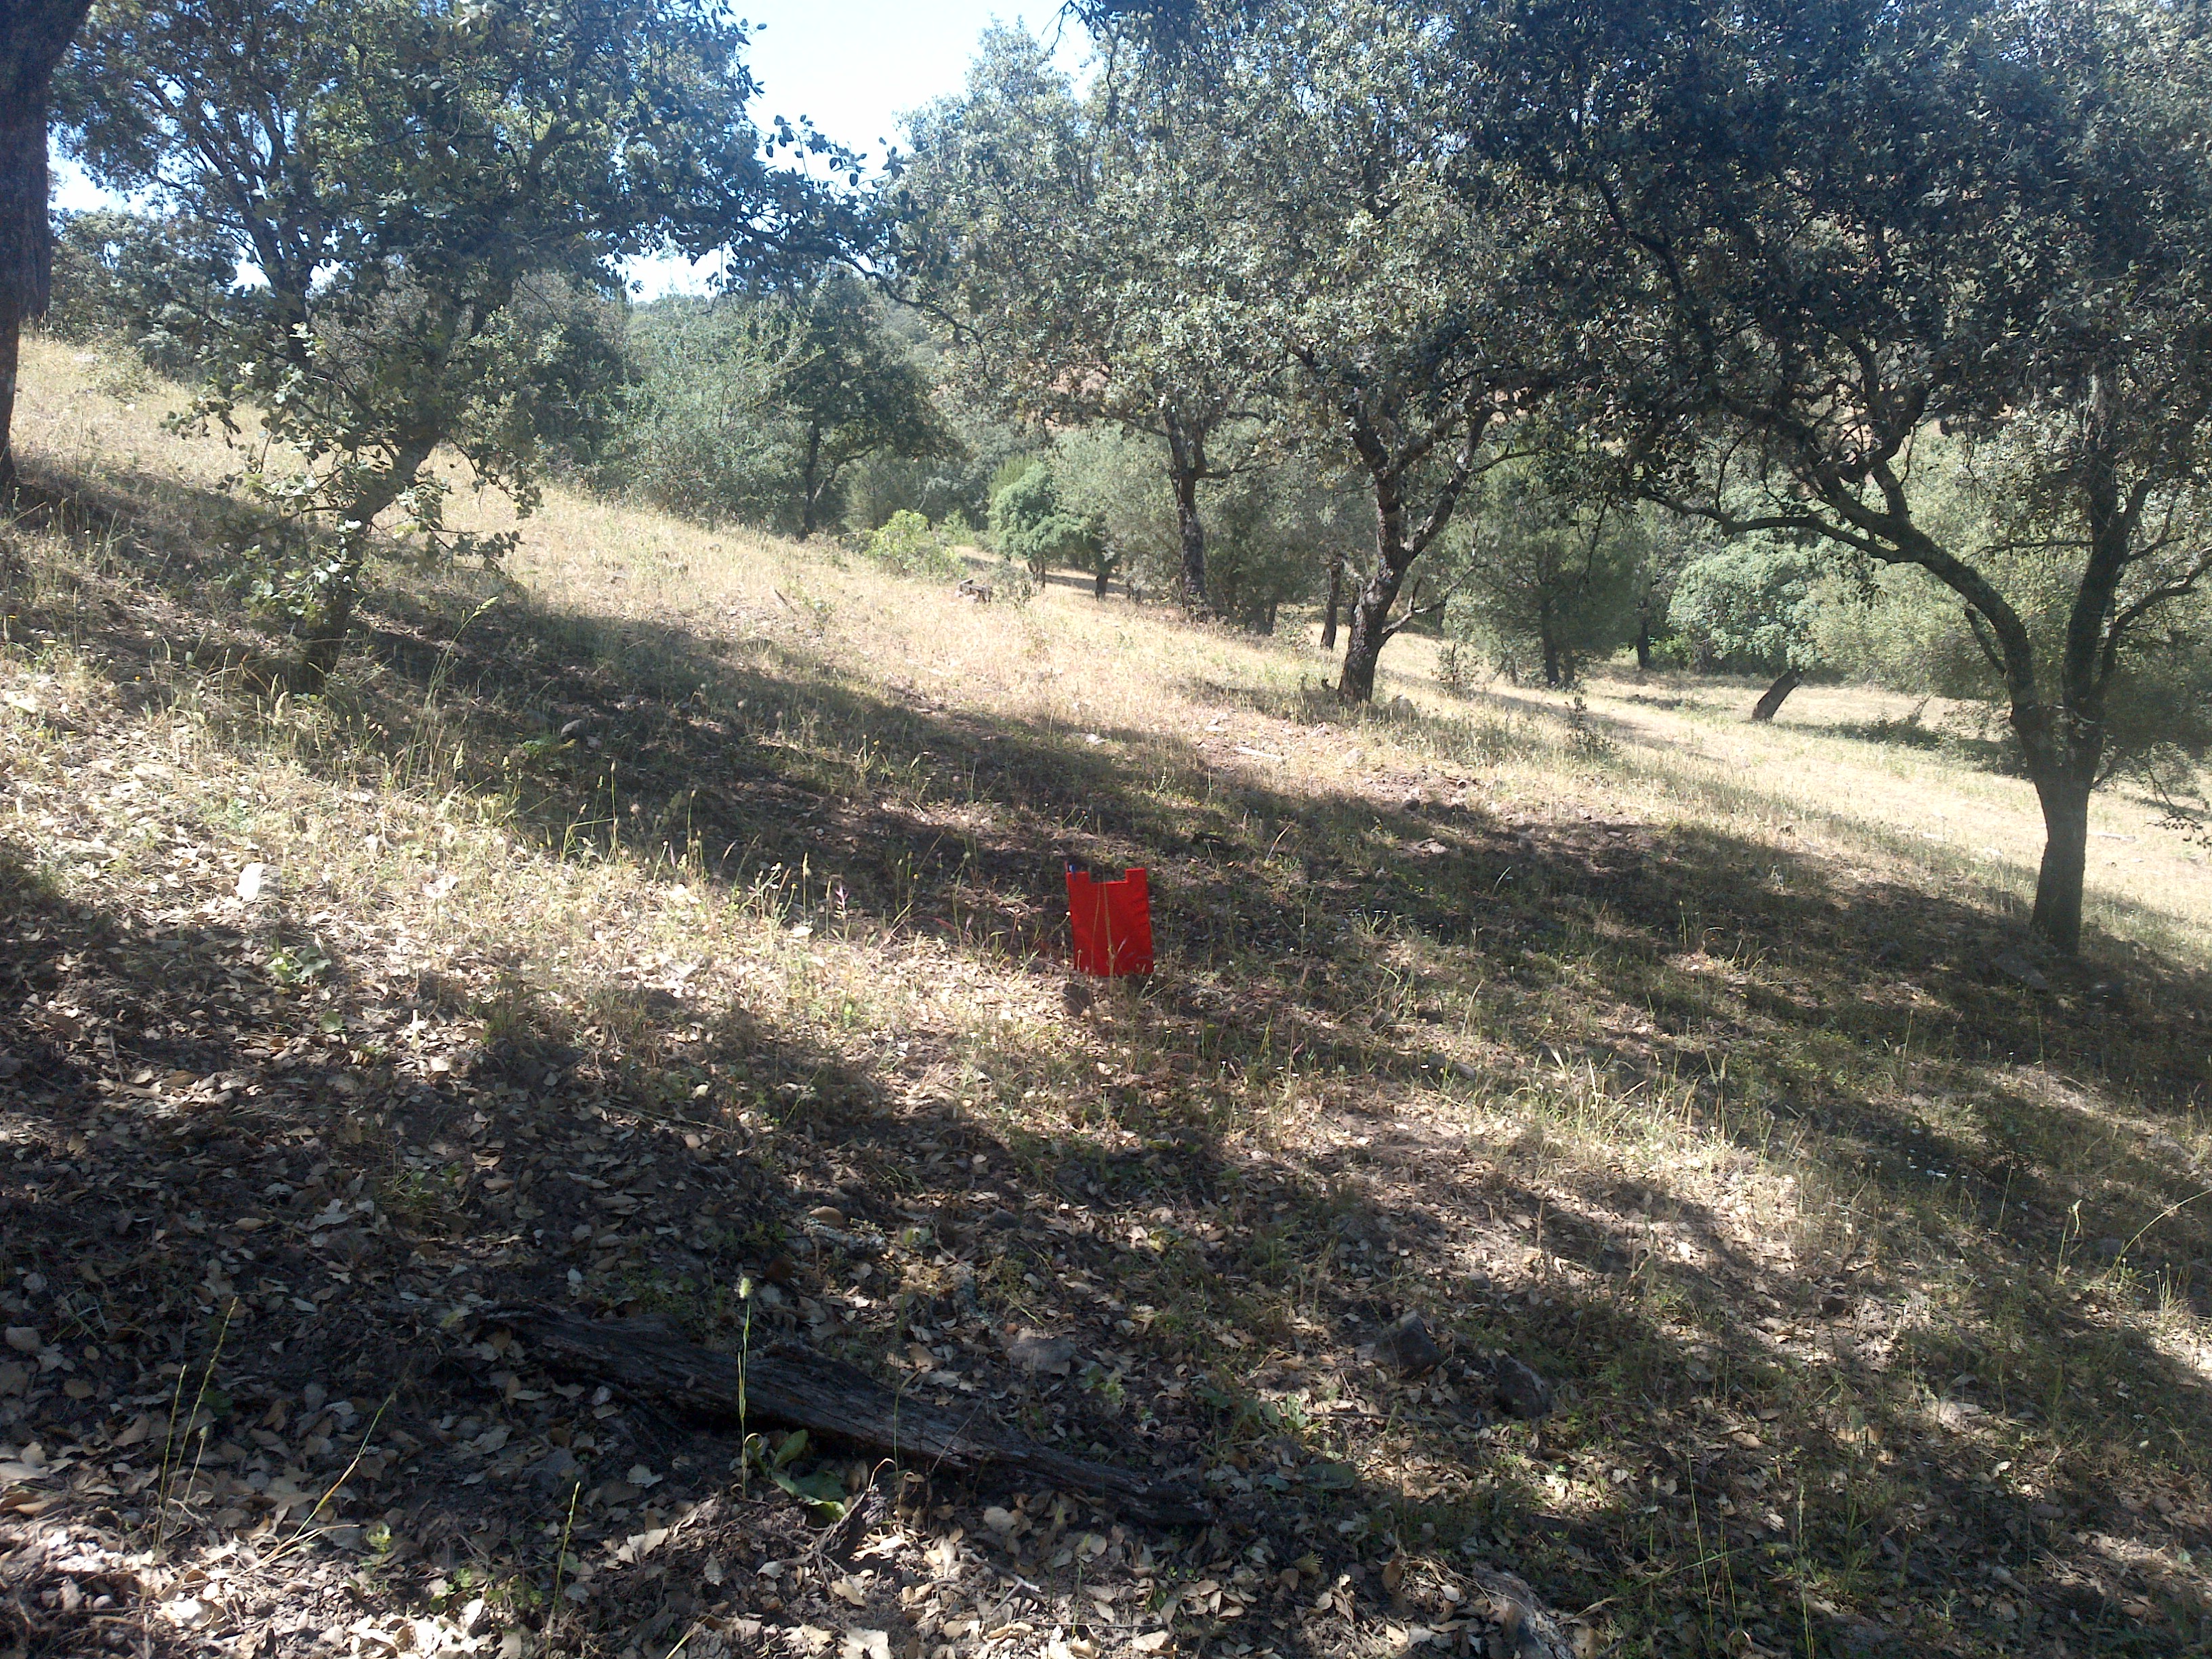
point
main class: Woodland
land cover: Broadleaved woodland
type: broadleaved evergreen forest
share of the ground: 50 - 75 %
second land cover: Spontaneously vegetated surfaces
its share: 10 - 25 %
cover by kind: broadleaved forest trees 60 %, shrubs 10 %, herbaceous plants 10 %, lichens and mosses 10 %, unconsolidated bare surface 10 %
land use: Forestry
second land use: Agriculture (excluding fallow land and kitchen gardens)
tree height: > 5 m
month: May
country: ES
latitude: 37.9195
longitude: -4.9534
